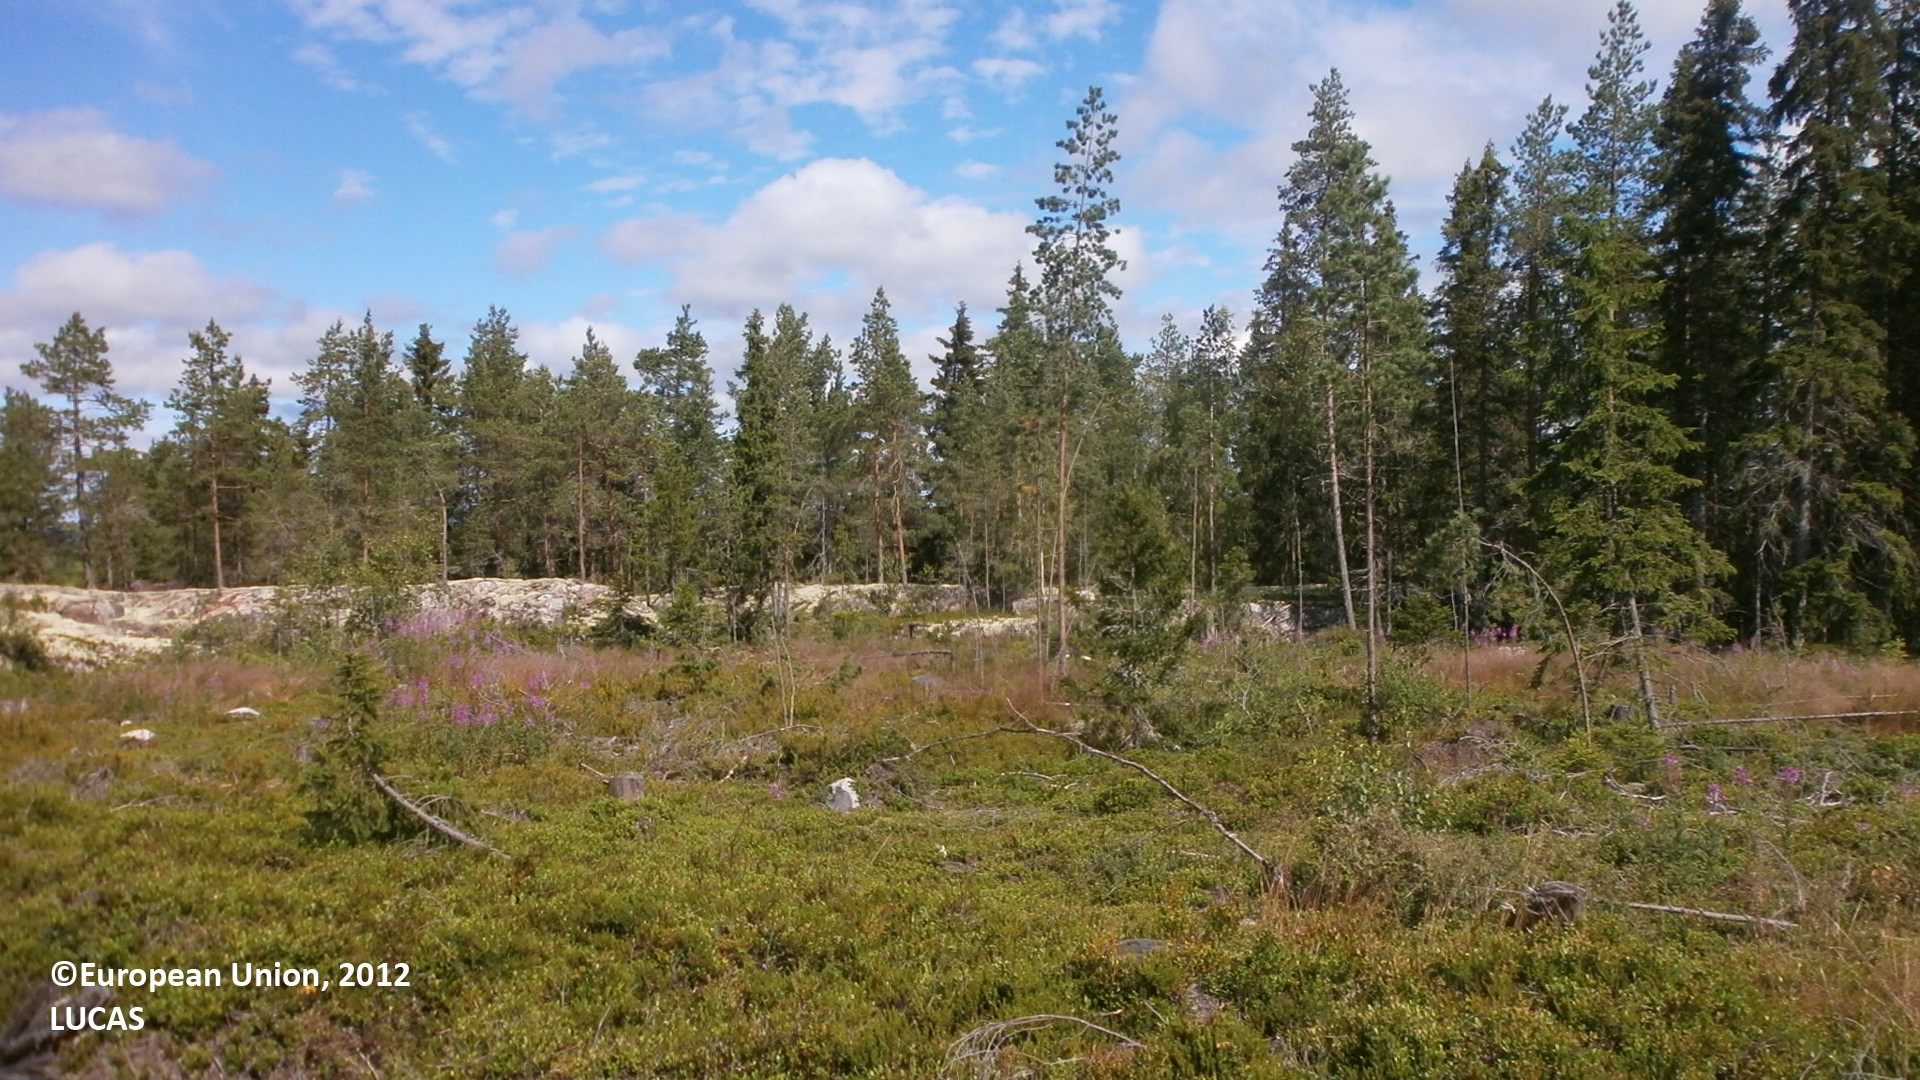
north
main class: Shrubland
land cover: Shrubland without tree cover
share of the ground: > 75 %
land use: Forestry
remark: Clear cut
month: July
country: FI
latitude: 64.0204
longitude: 23.7075
